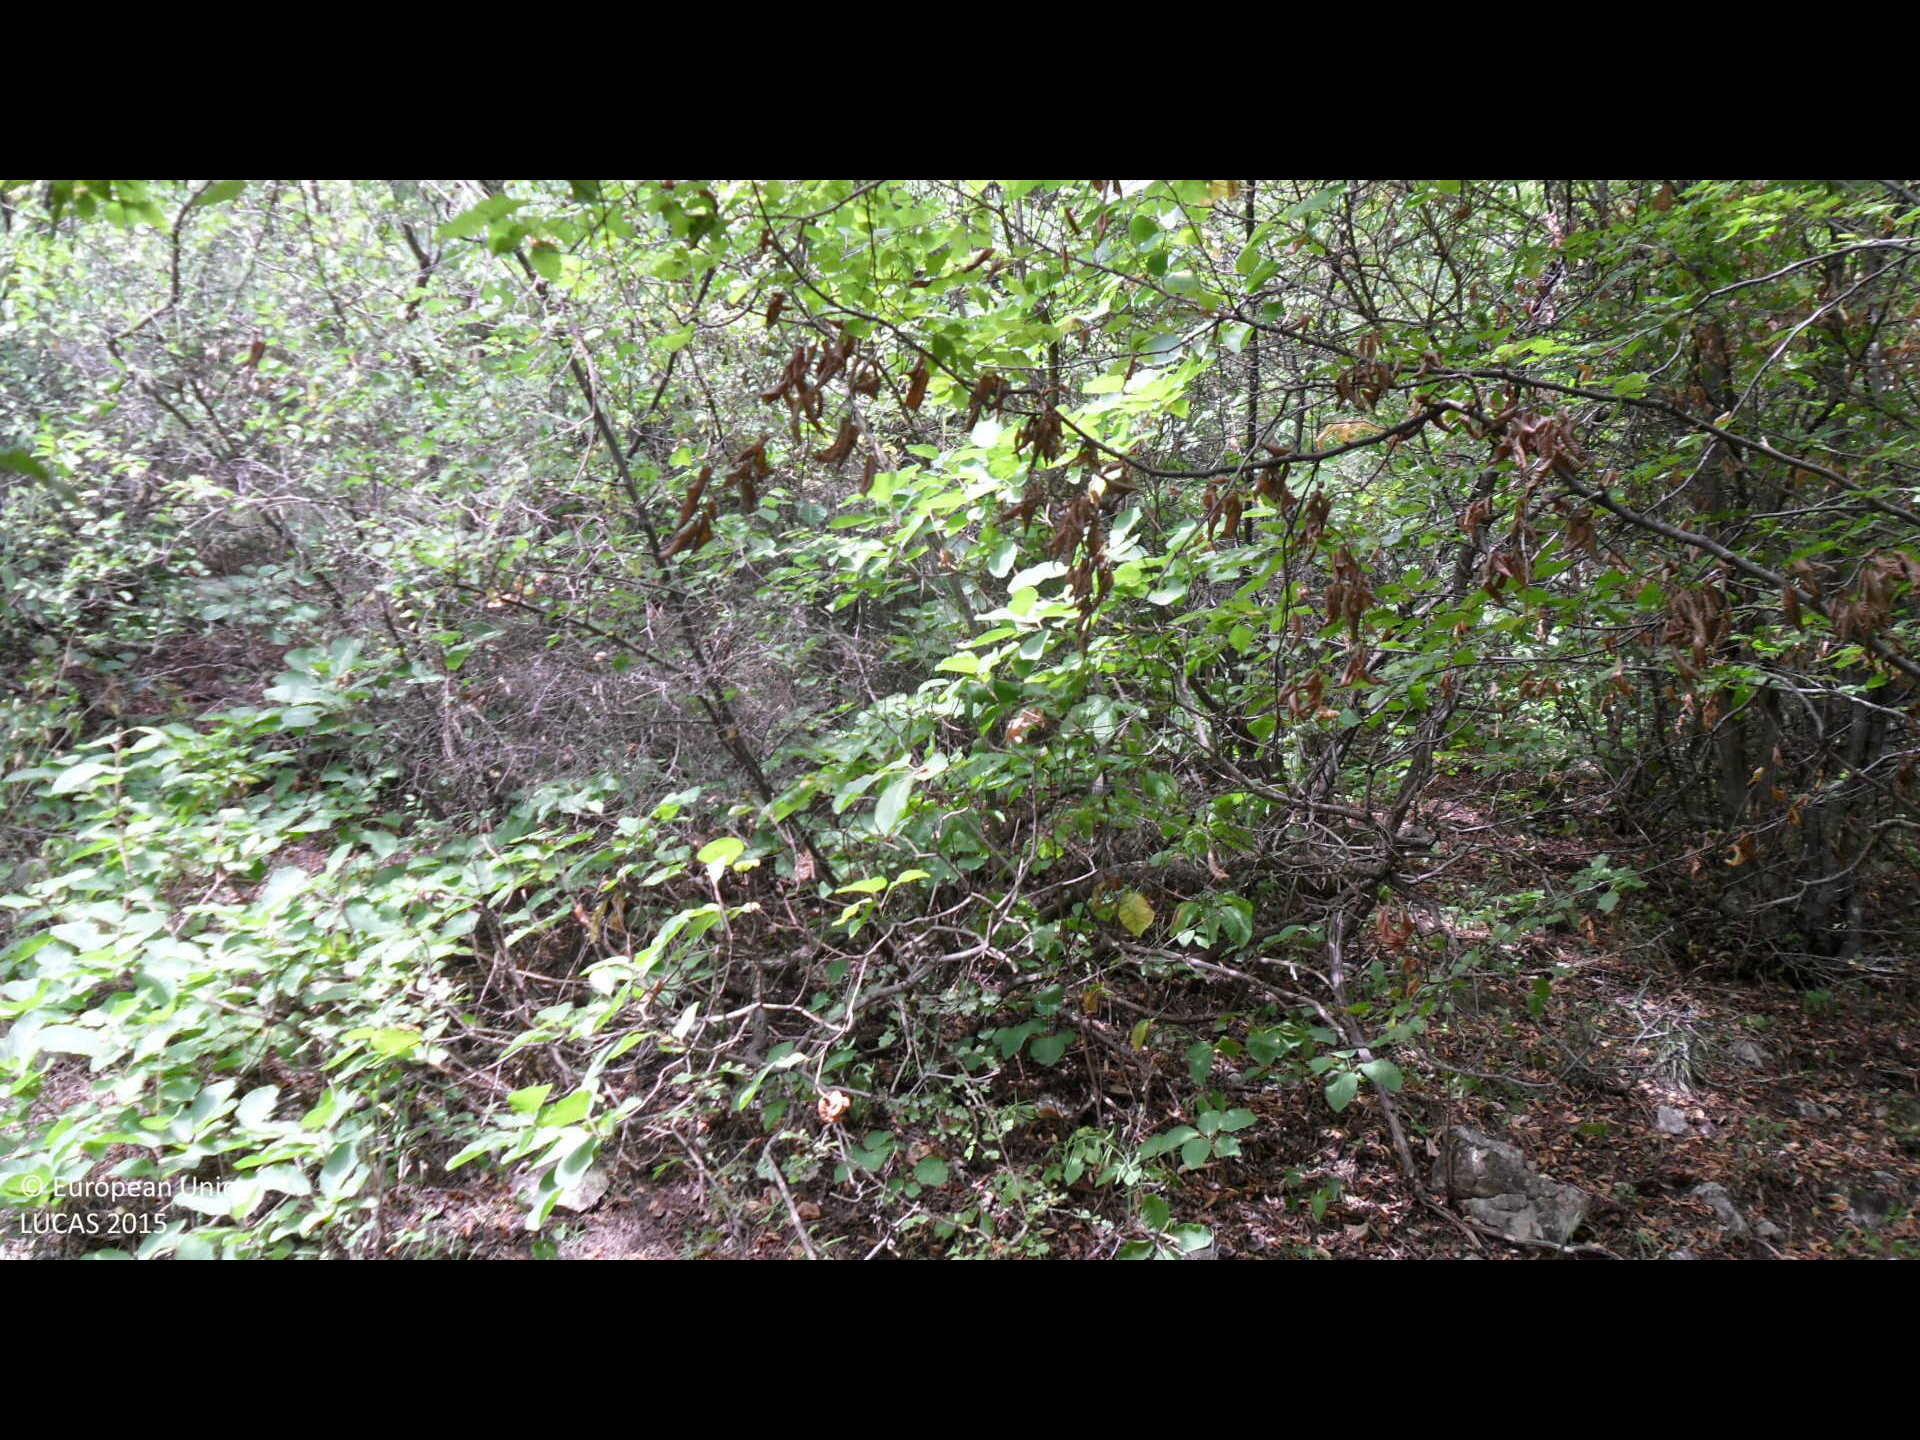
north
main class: Woodland
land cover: Broadleaved woodland
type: mesophytic deciduous forest
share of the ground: 50 - 75 %
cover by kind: broadleaved forest trees 100 %
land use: Forestry
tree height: > 5 m
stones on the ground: 10 - 25 %
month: August
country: BG
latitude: 43.5137
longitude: 26.1657
